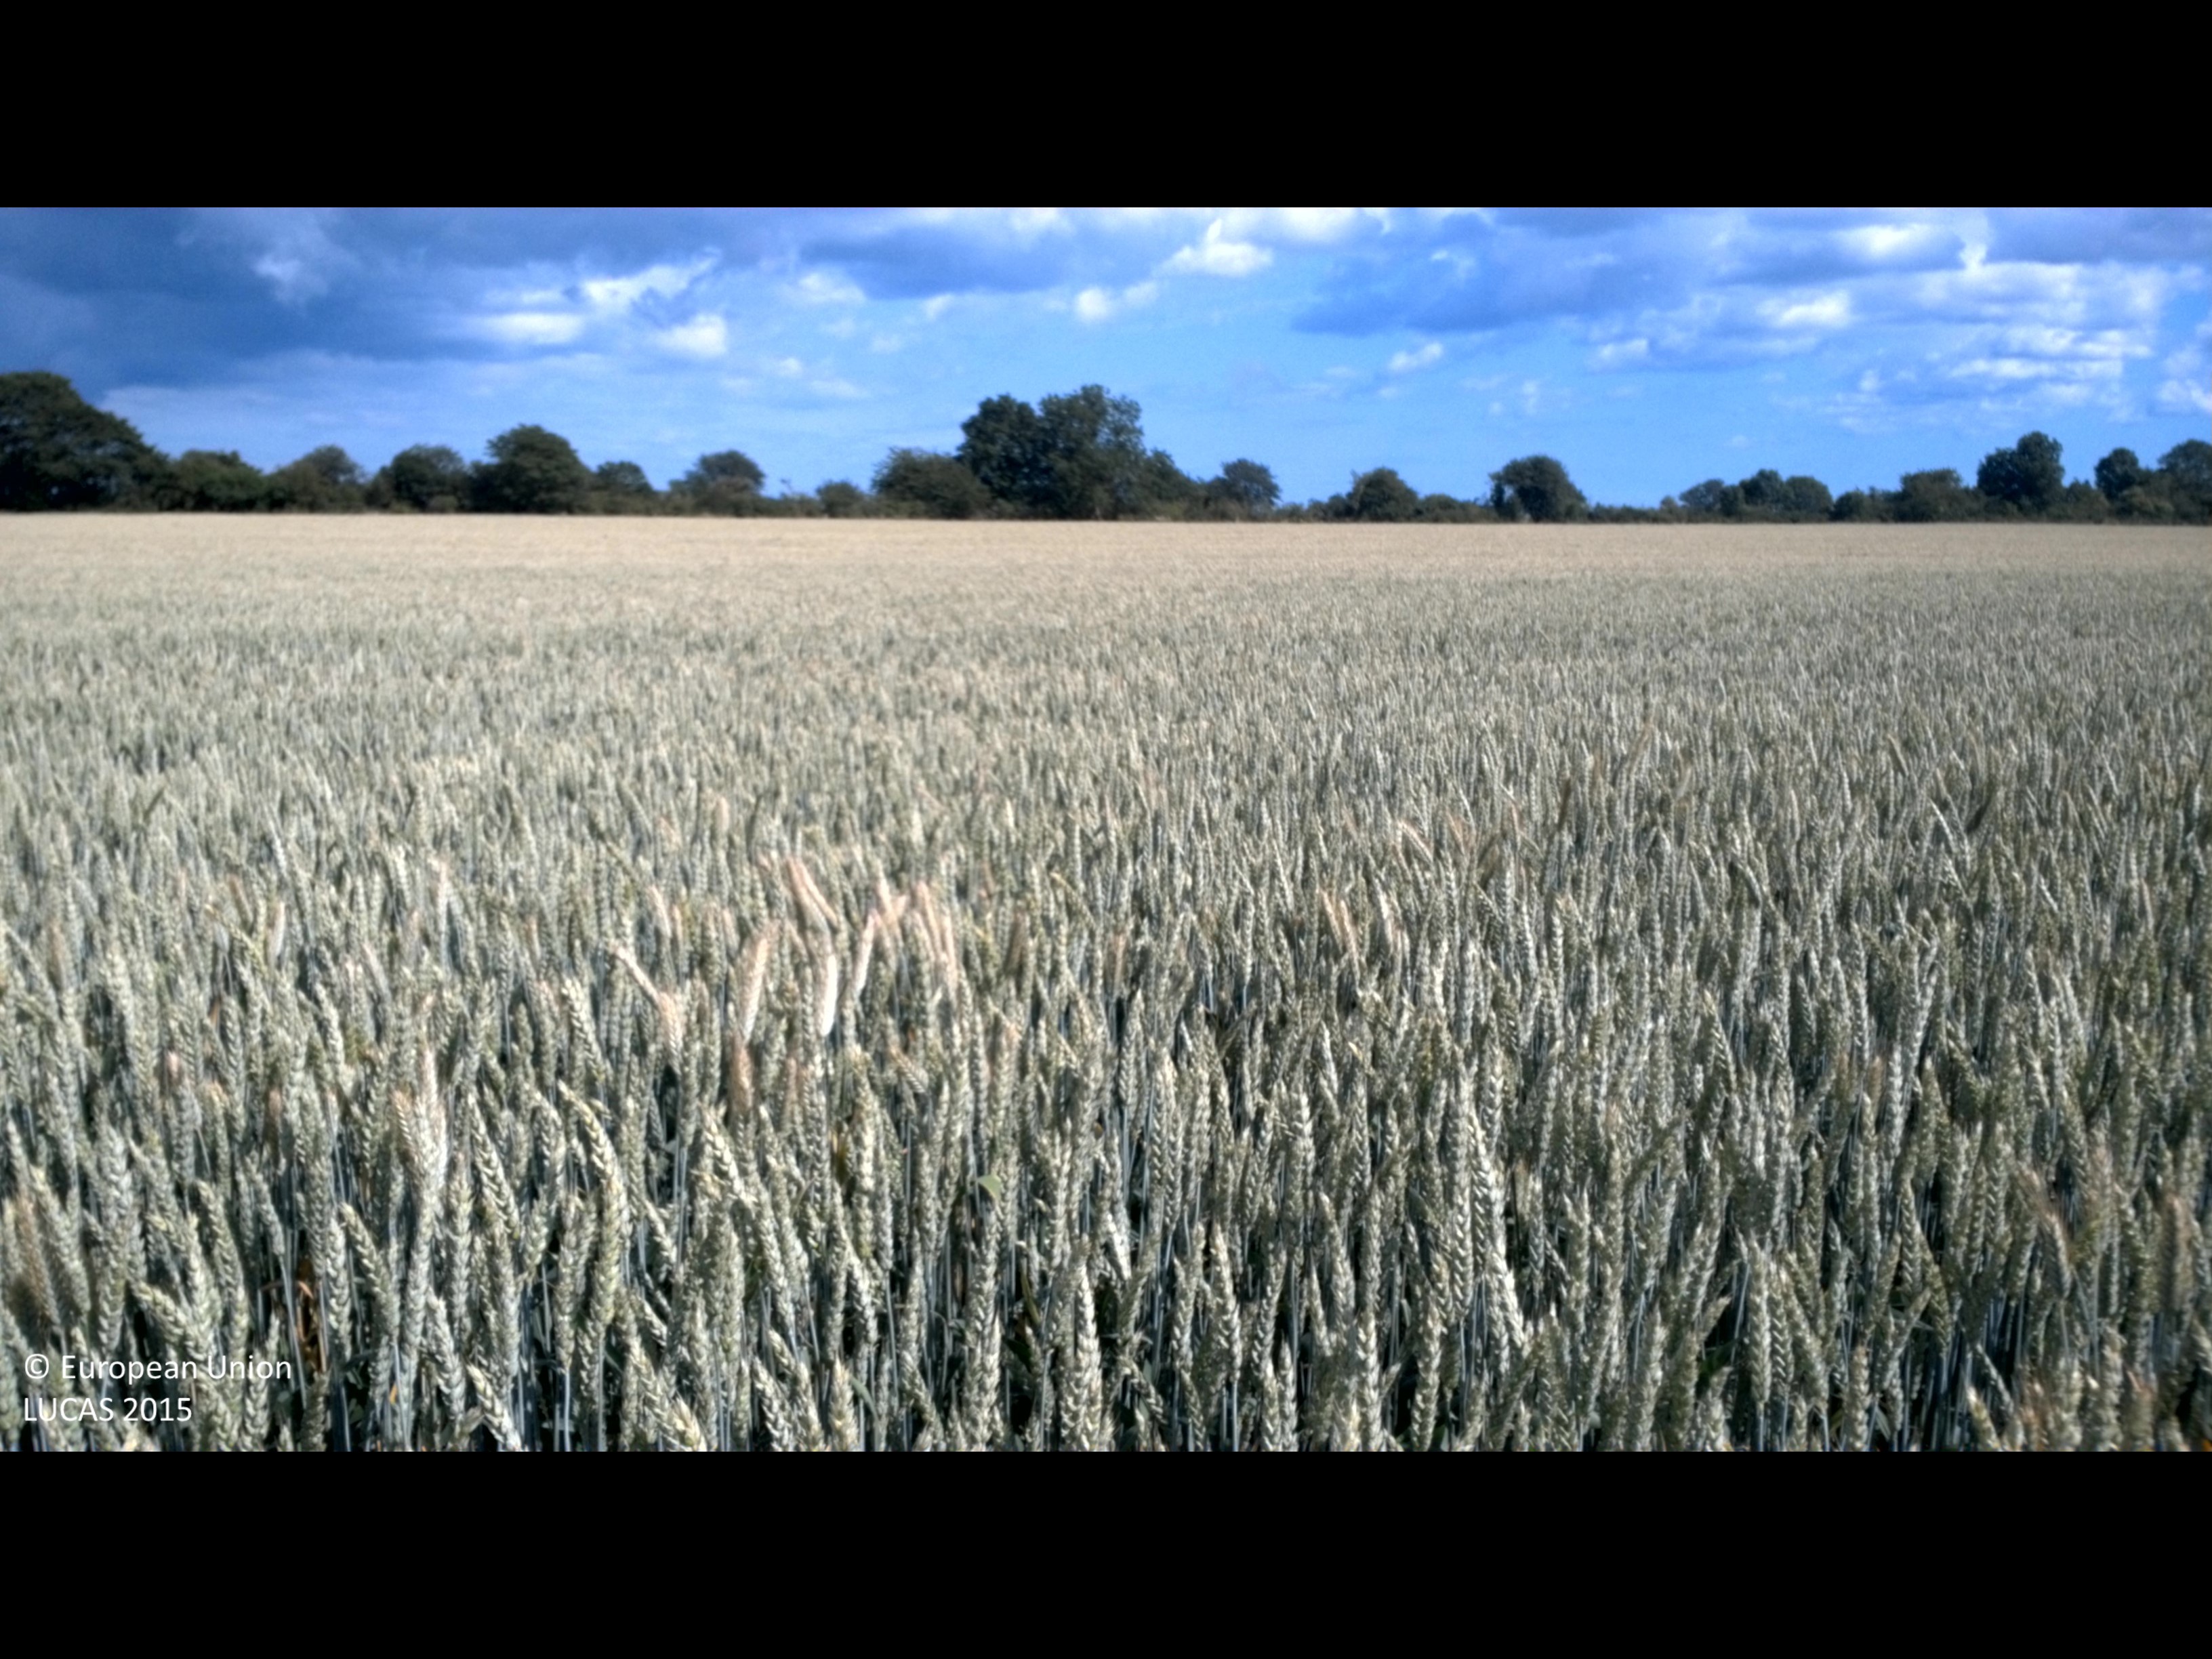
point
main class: Cropland
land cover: Common wheat
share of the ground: > 75 %
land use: Agriculture (excluding fallow land and kitchen gardens)
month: July
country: SE
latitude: 56.5841
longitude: 16.4652
